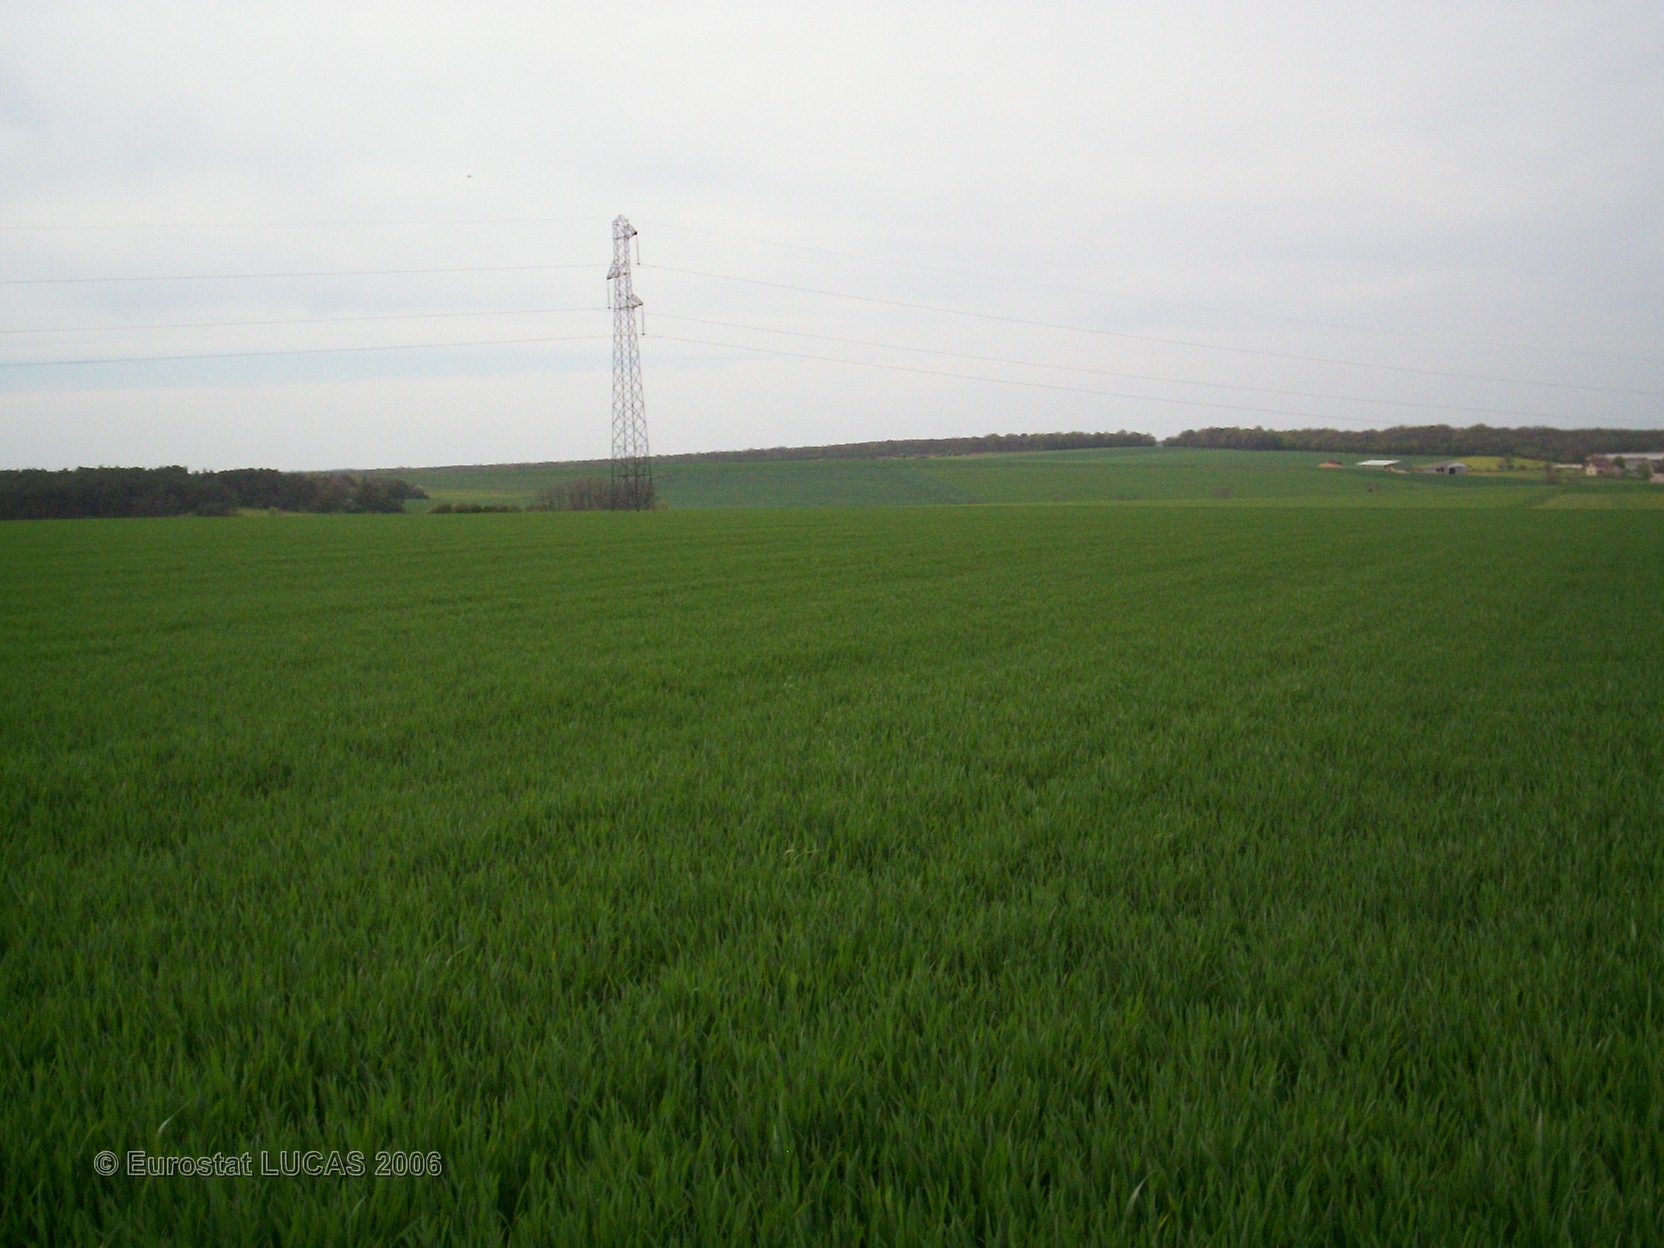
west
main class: Cropland
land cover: Common wheat
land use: Agriculture (excluding fallow land and kitchen gardens)
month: May
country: FR
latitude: 47.6368
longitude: 4.5286
